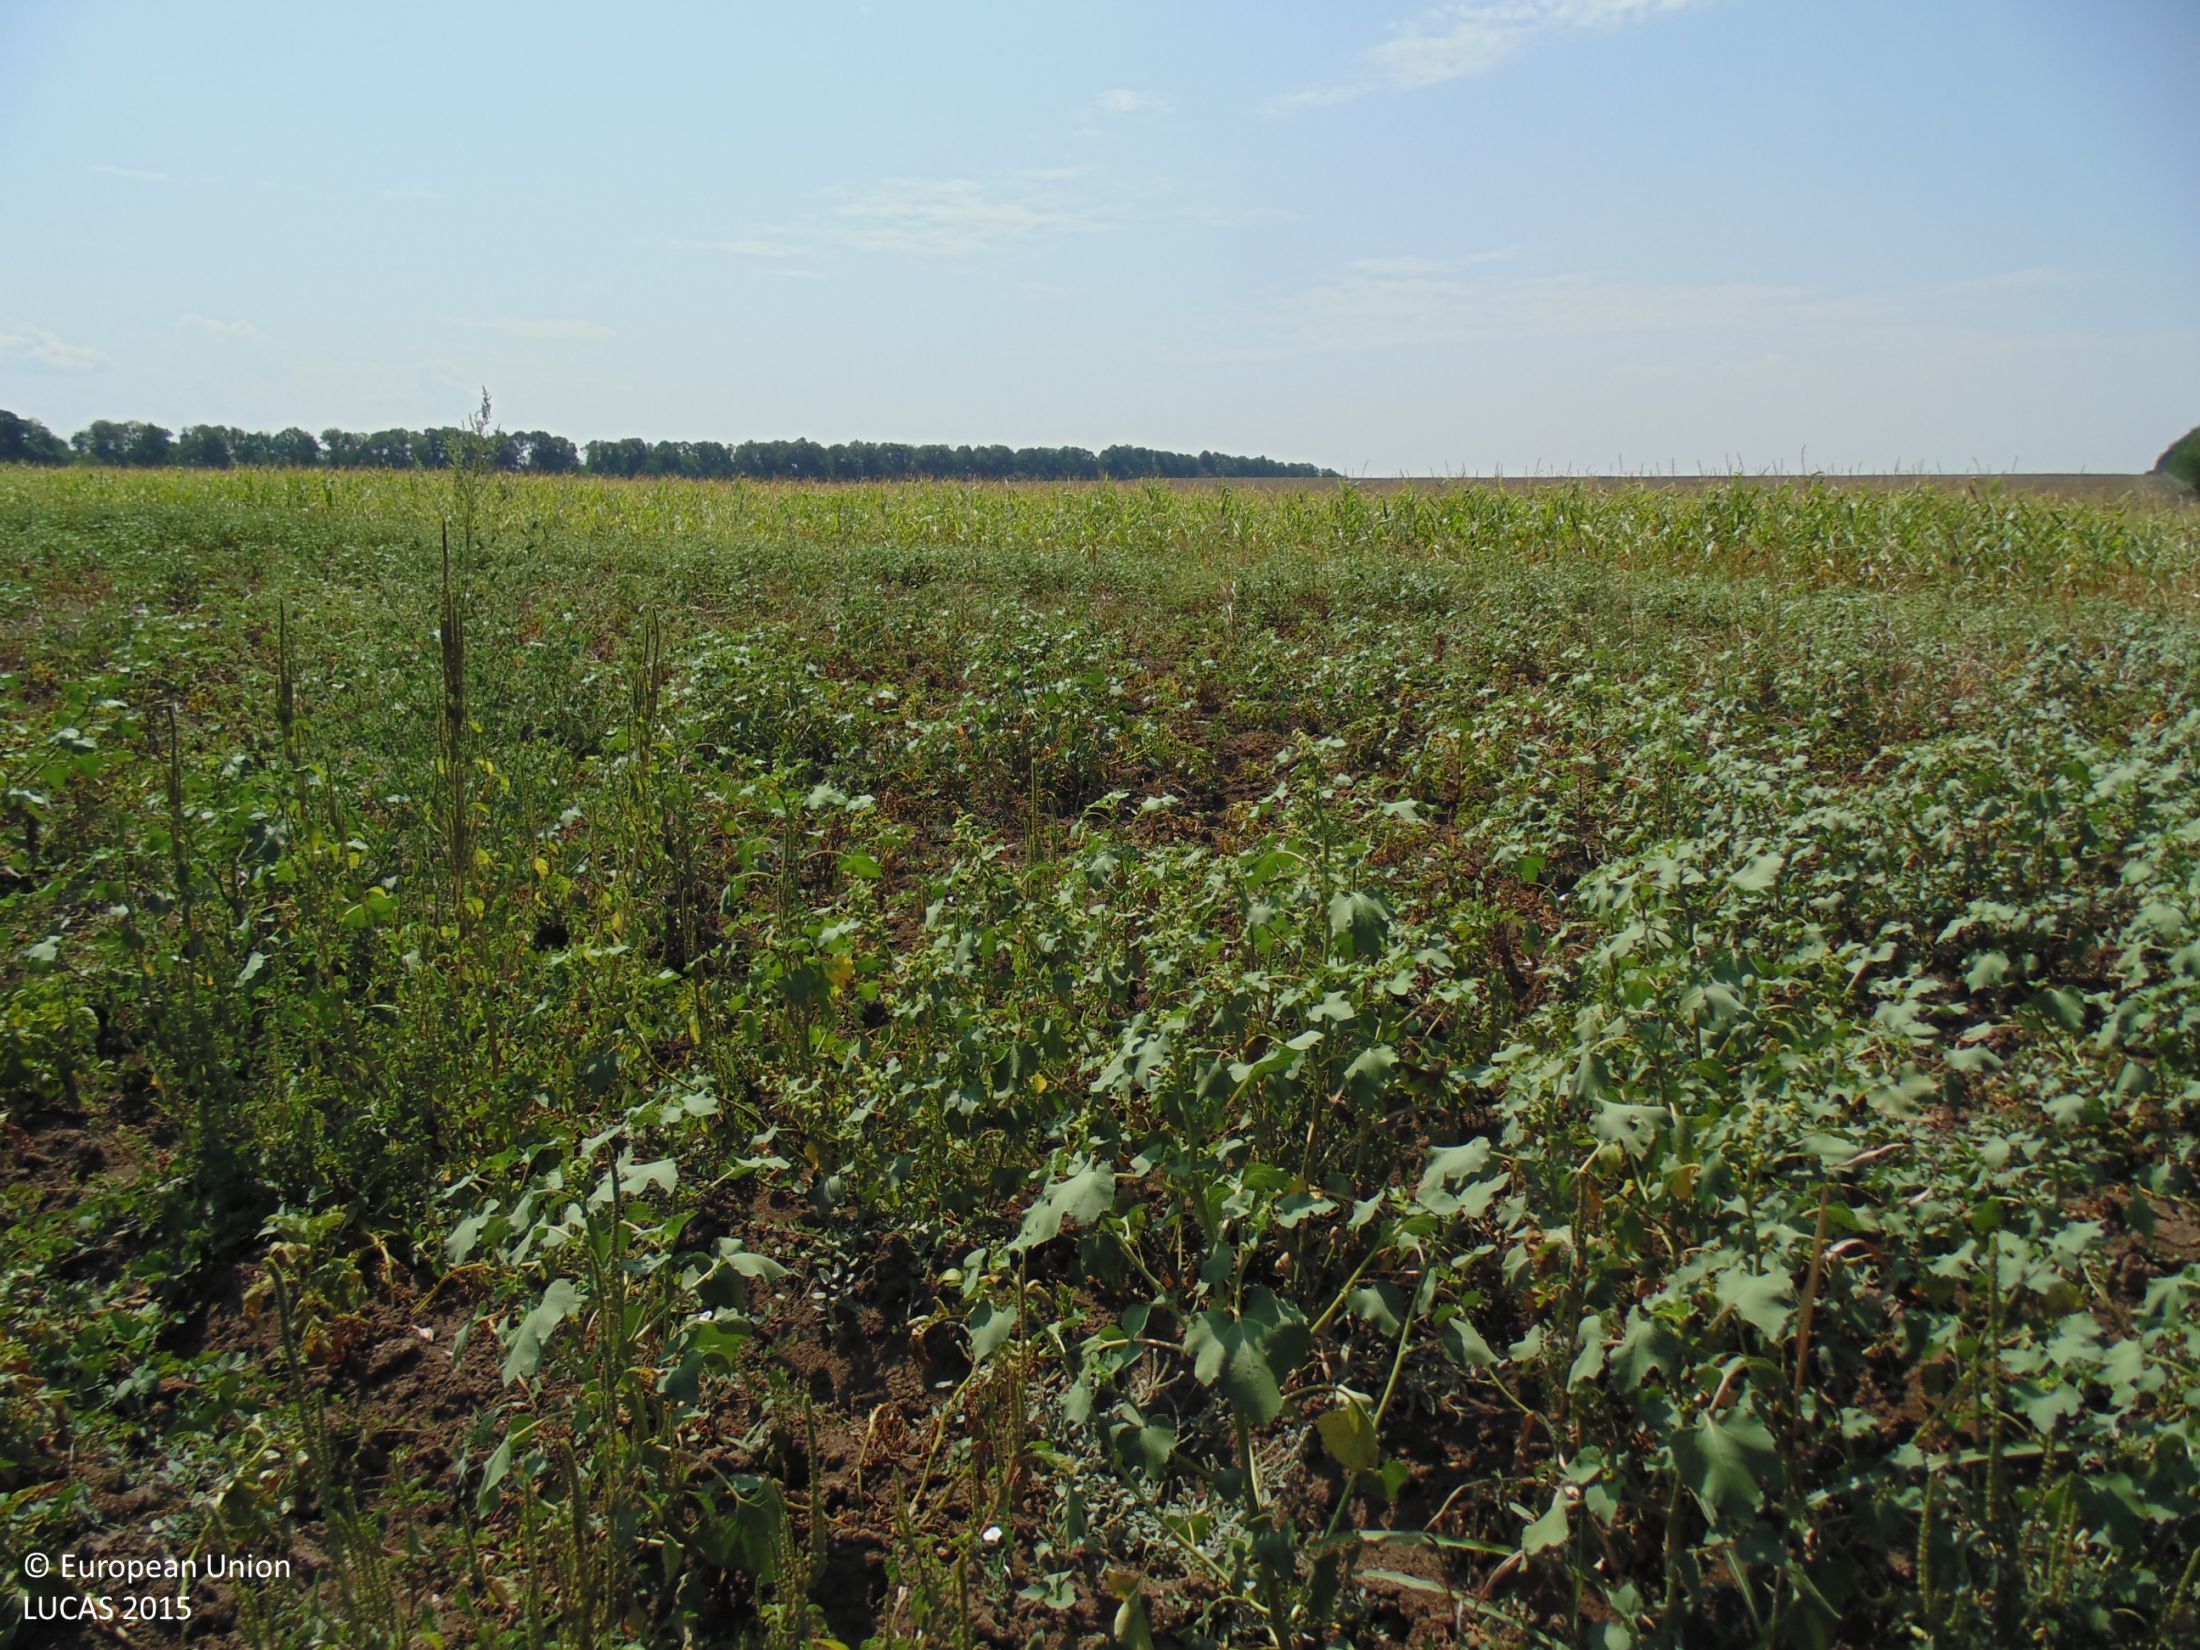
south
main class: Cropland
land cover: Potatoes
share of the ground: > 75 %
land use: Agriculture (excluding fallow land and kitchen gardens)
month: August
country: BG
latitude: 43.7120
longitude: 27.6243
